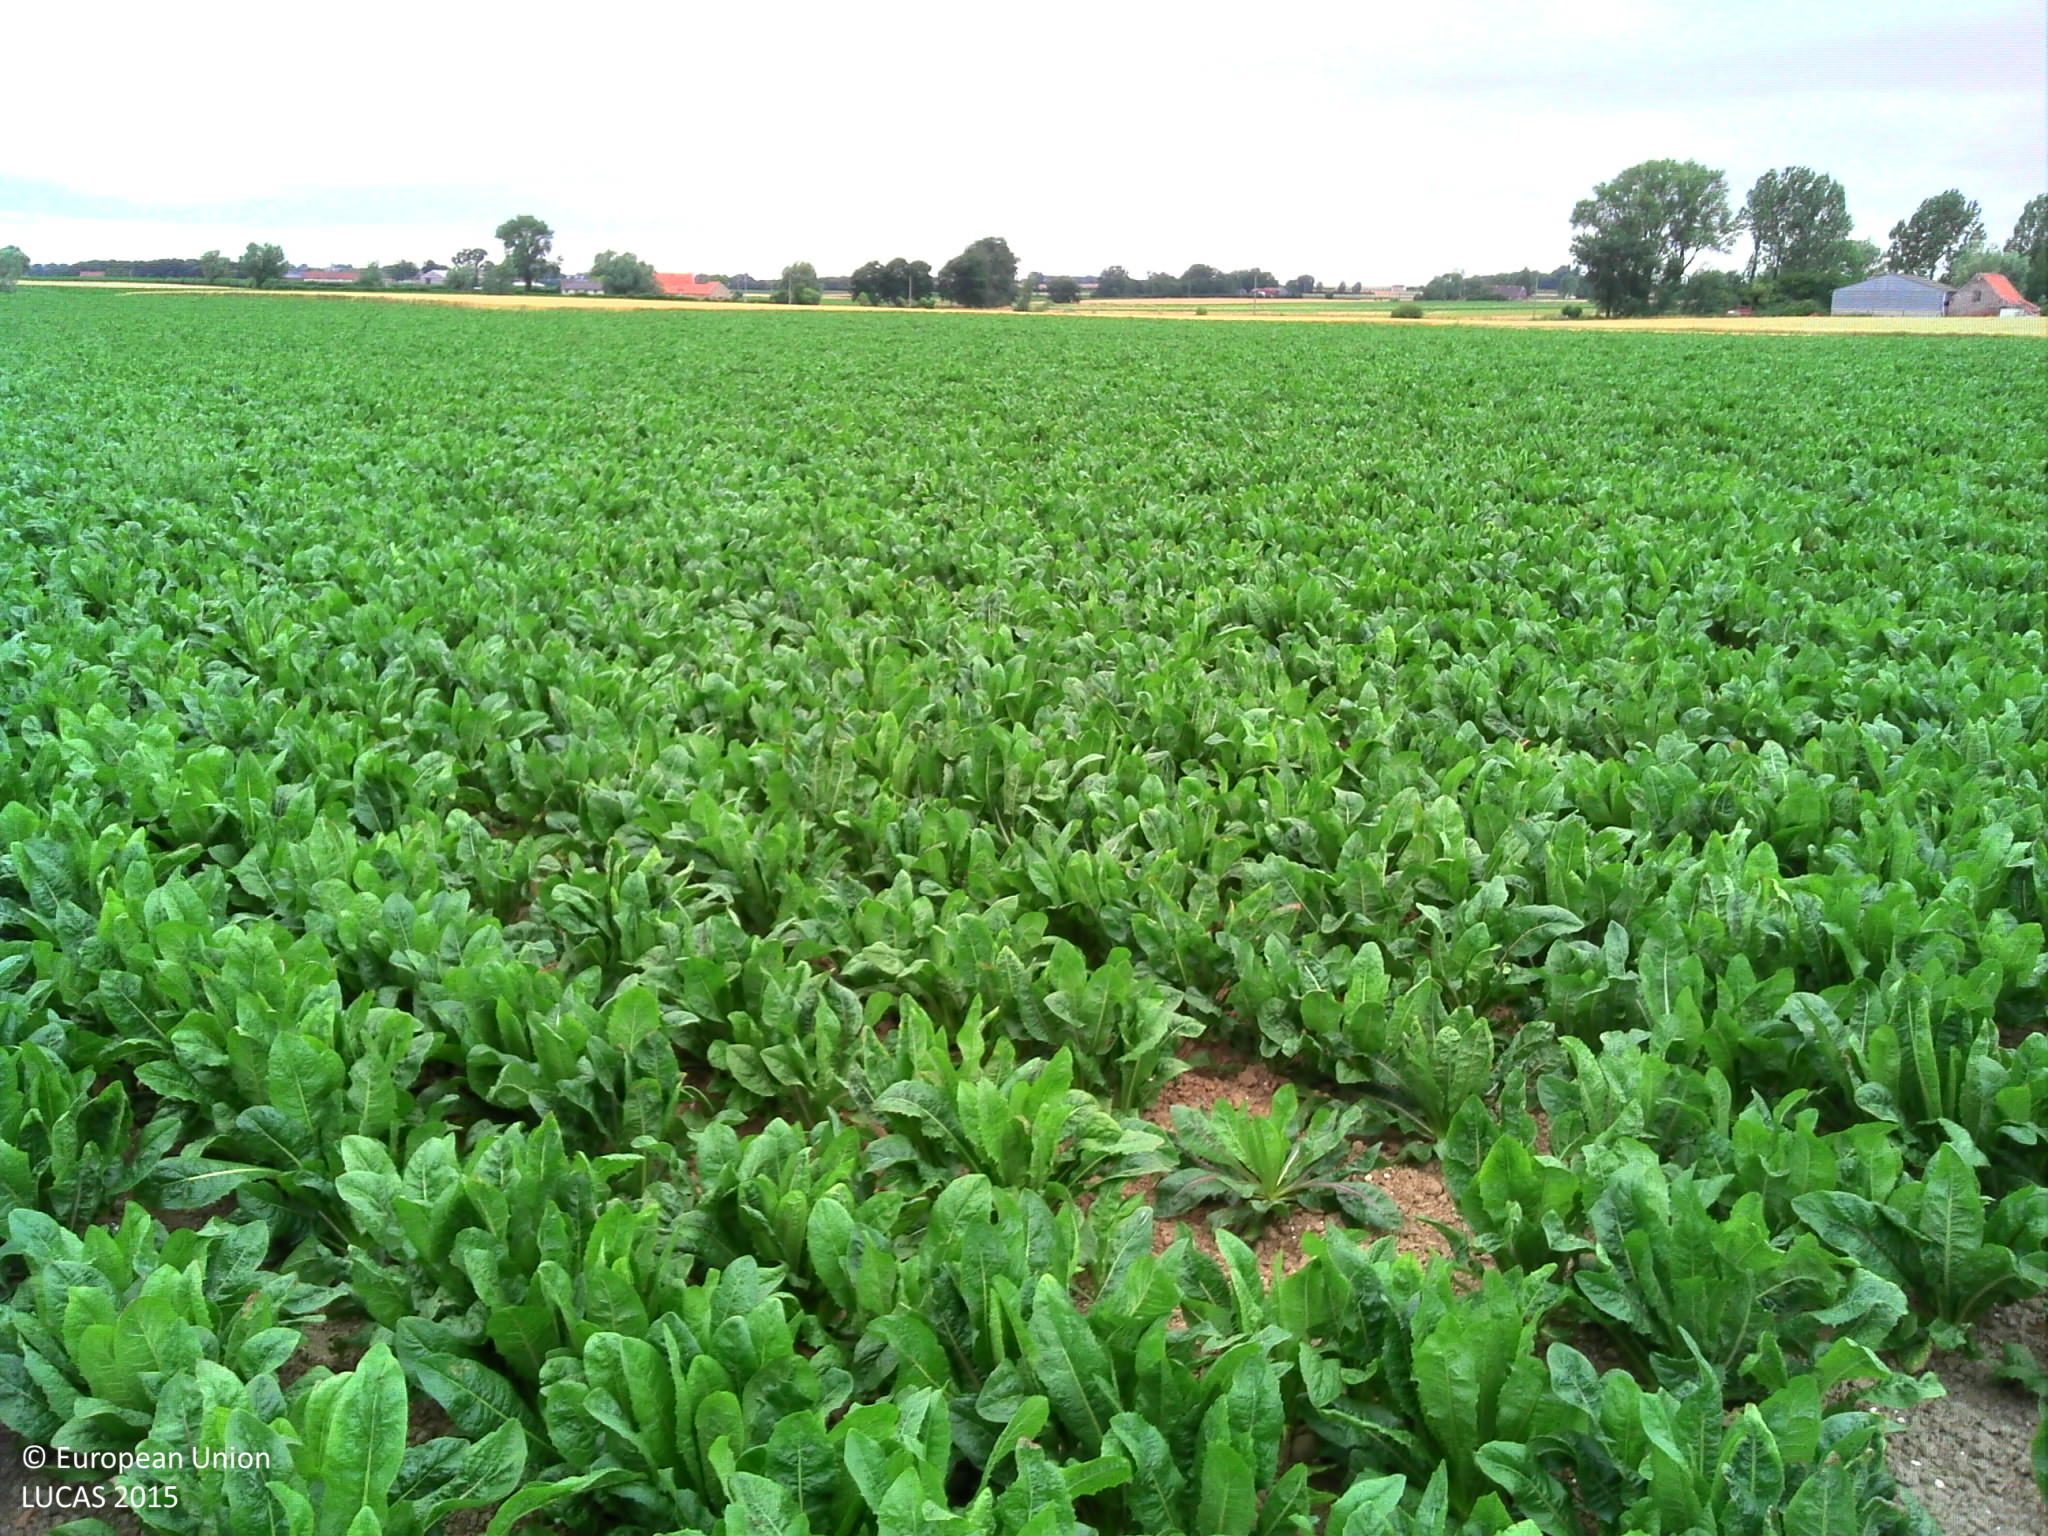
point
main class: Cropland
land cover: Sugar beet
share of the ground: > 75 %
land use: Agriculture (excluding fallow land and kitchen gardens)
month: July
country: FR
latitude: 50.8686
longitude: 2.3845
